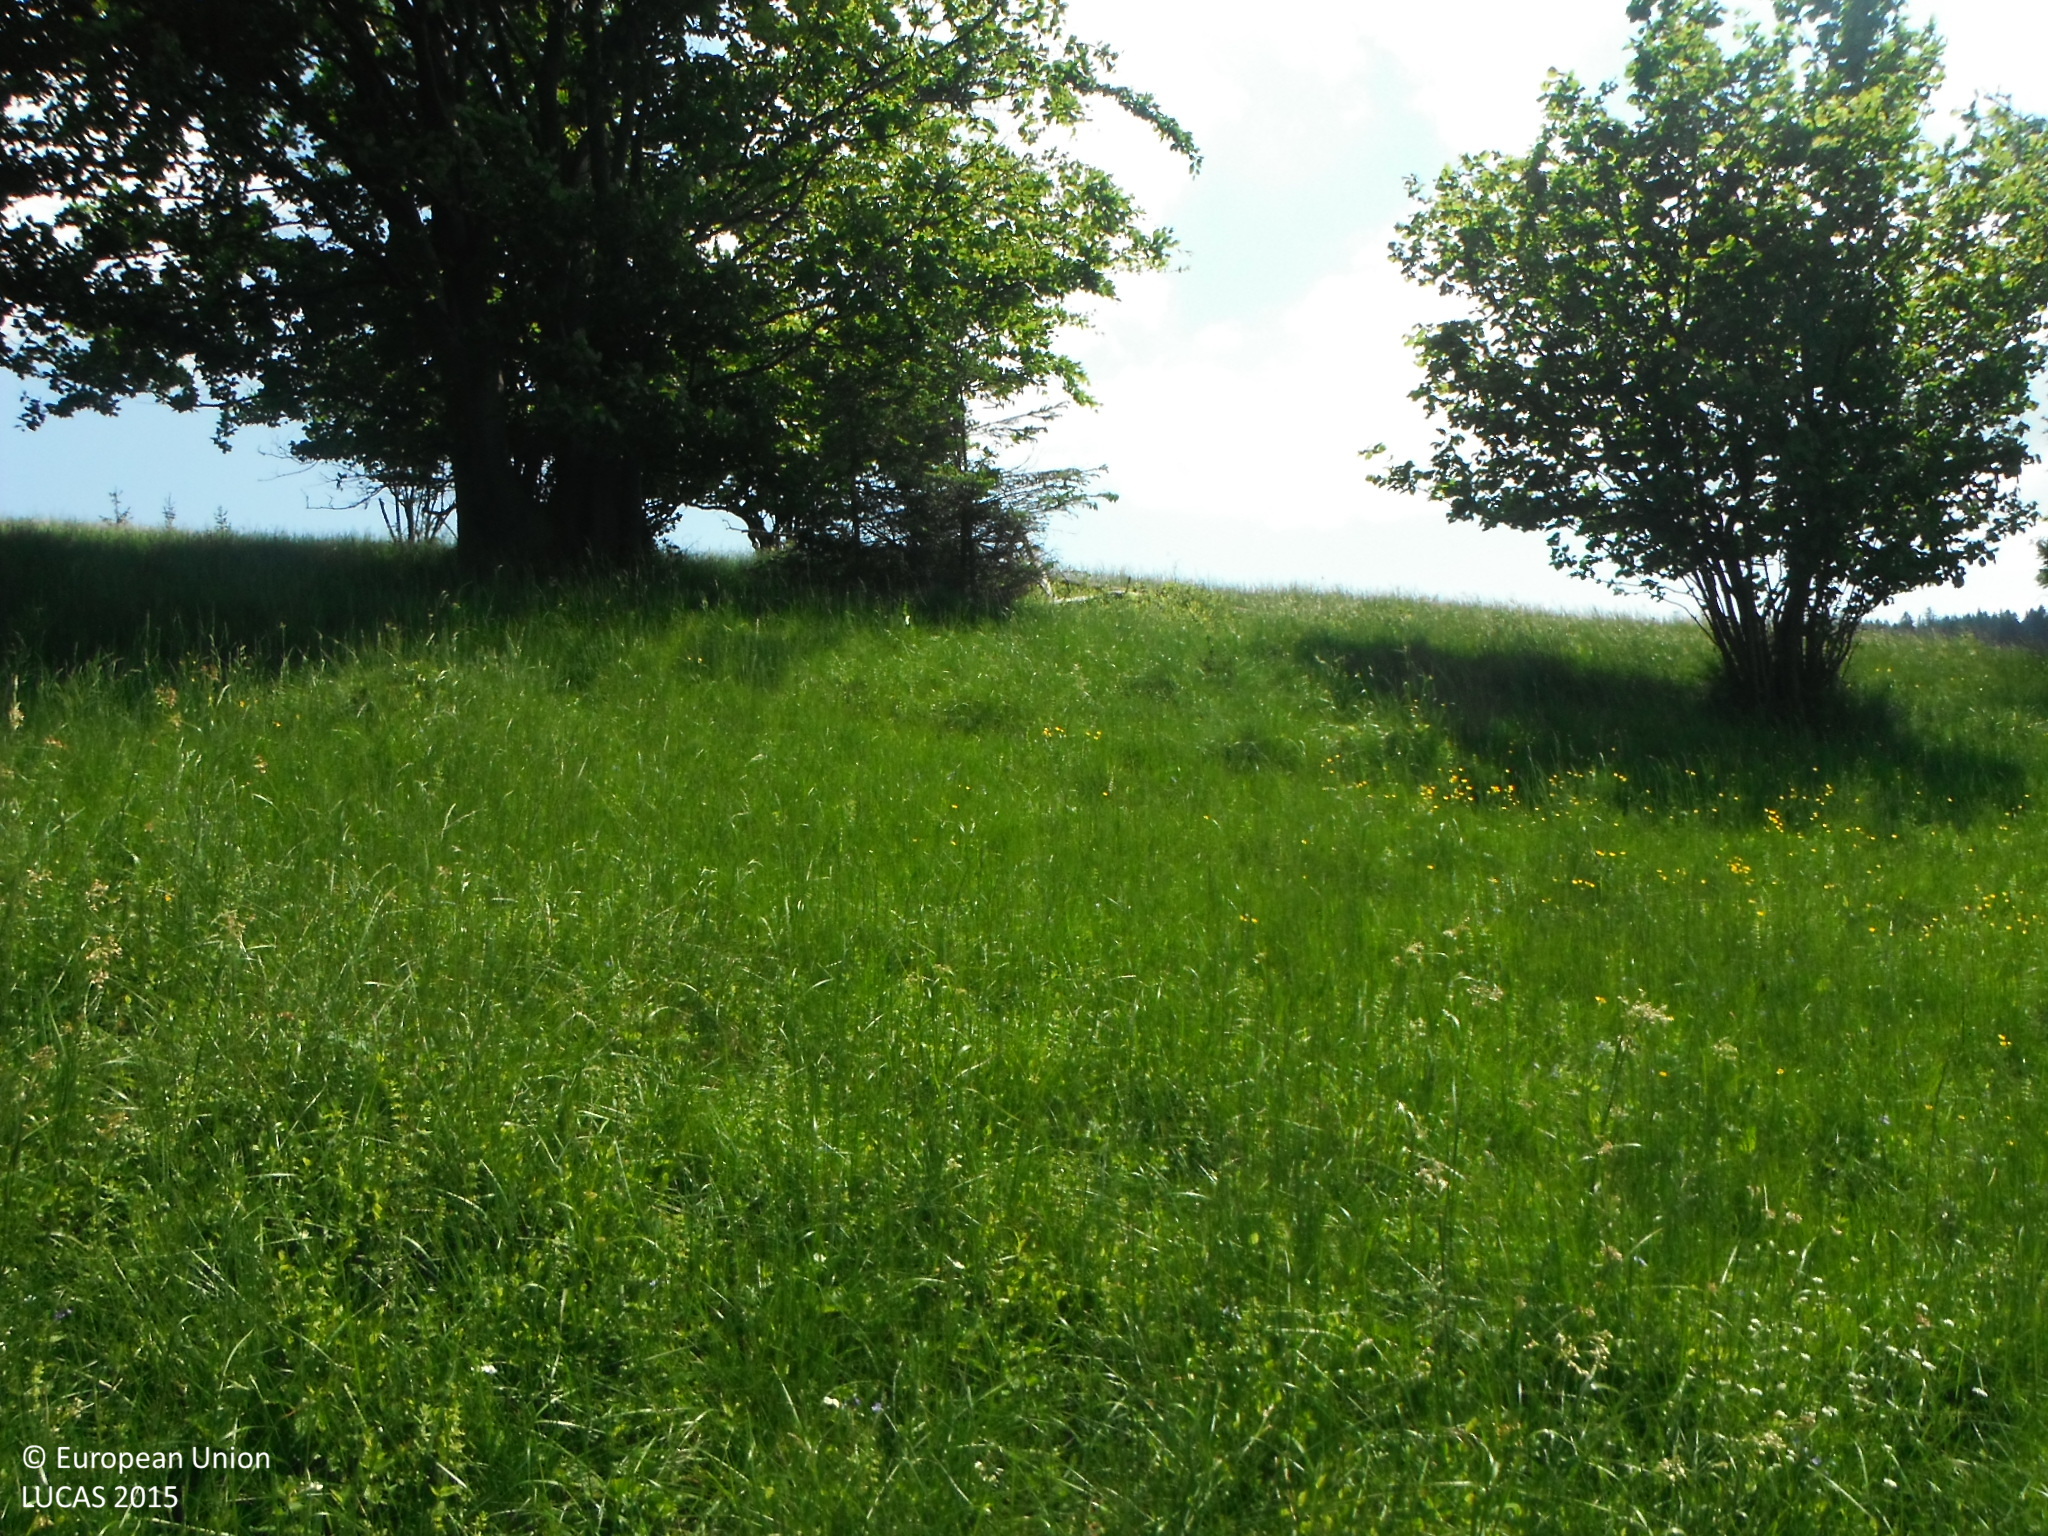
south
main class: Woodland
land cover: Spruce dominated mixed woodland
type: hemiboreal forest and nemoral coniferous forest and mixed broadleaved-coniferous forest
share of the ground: 25 - 50 %
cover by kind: herbaceous plants 60 %, coniferous forest trees 20 %, broadleaved forest trees 20 %
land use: Agriculture (excluding fallow land and kitchen gardens)
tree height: > 5 m
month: June
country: SK
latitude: 49.2887
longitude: 20.4159
